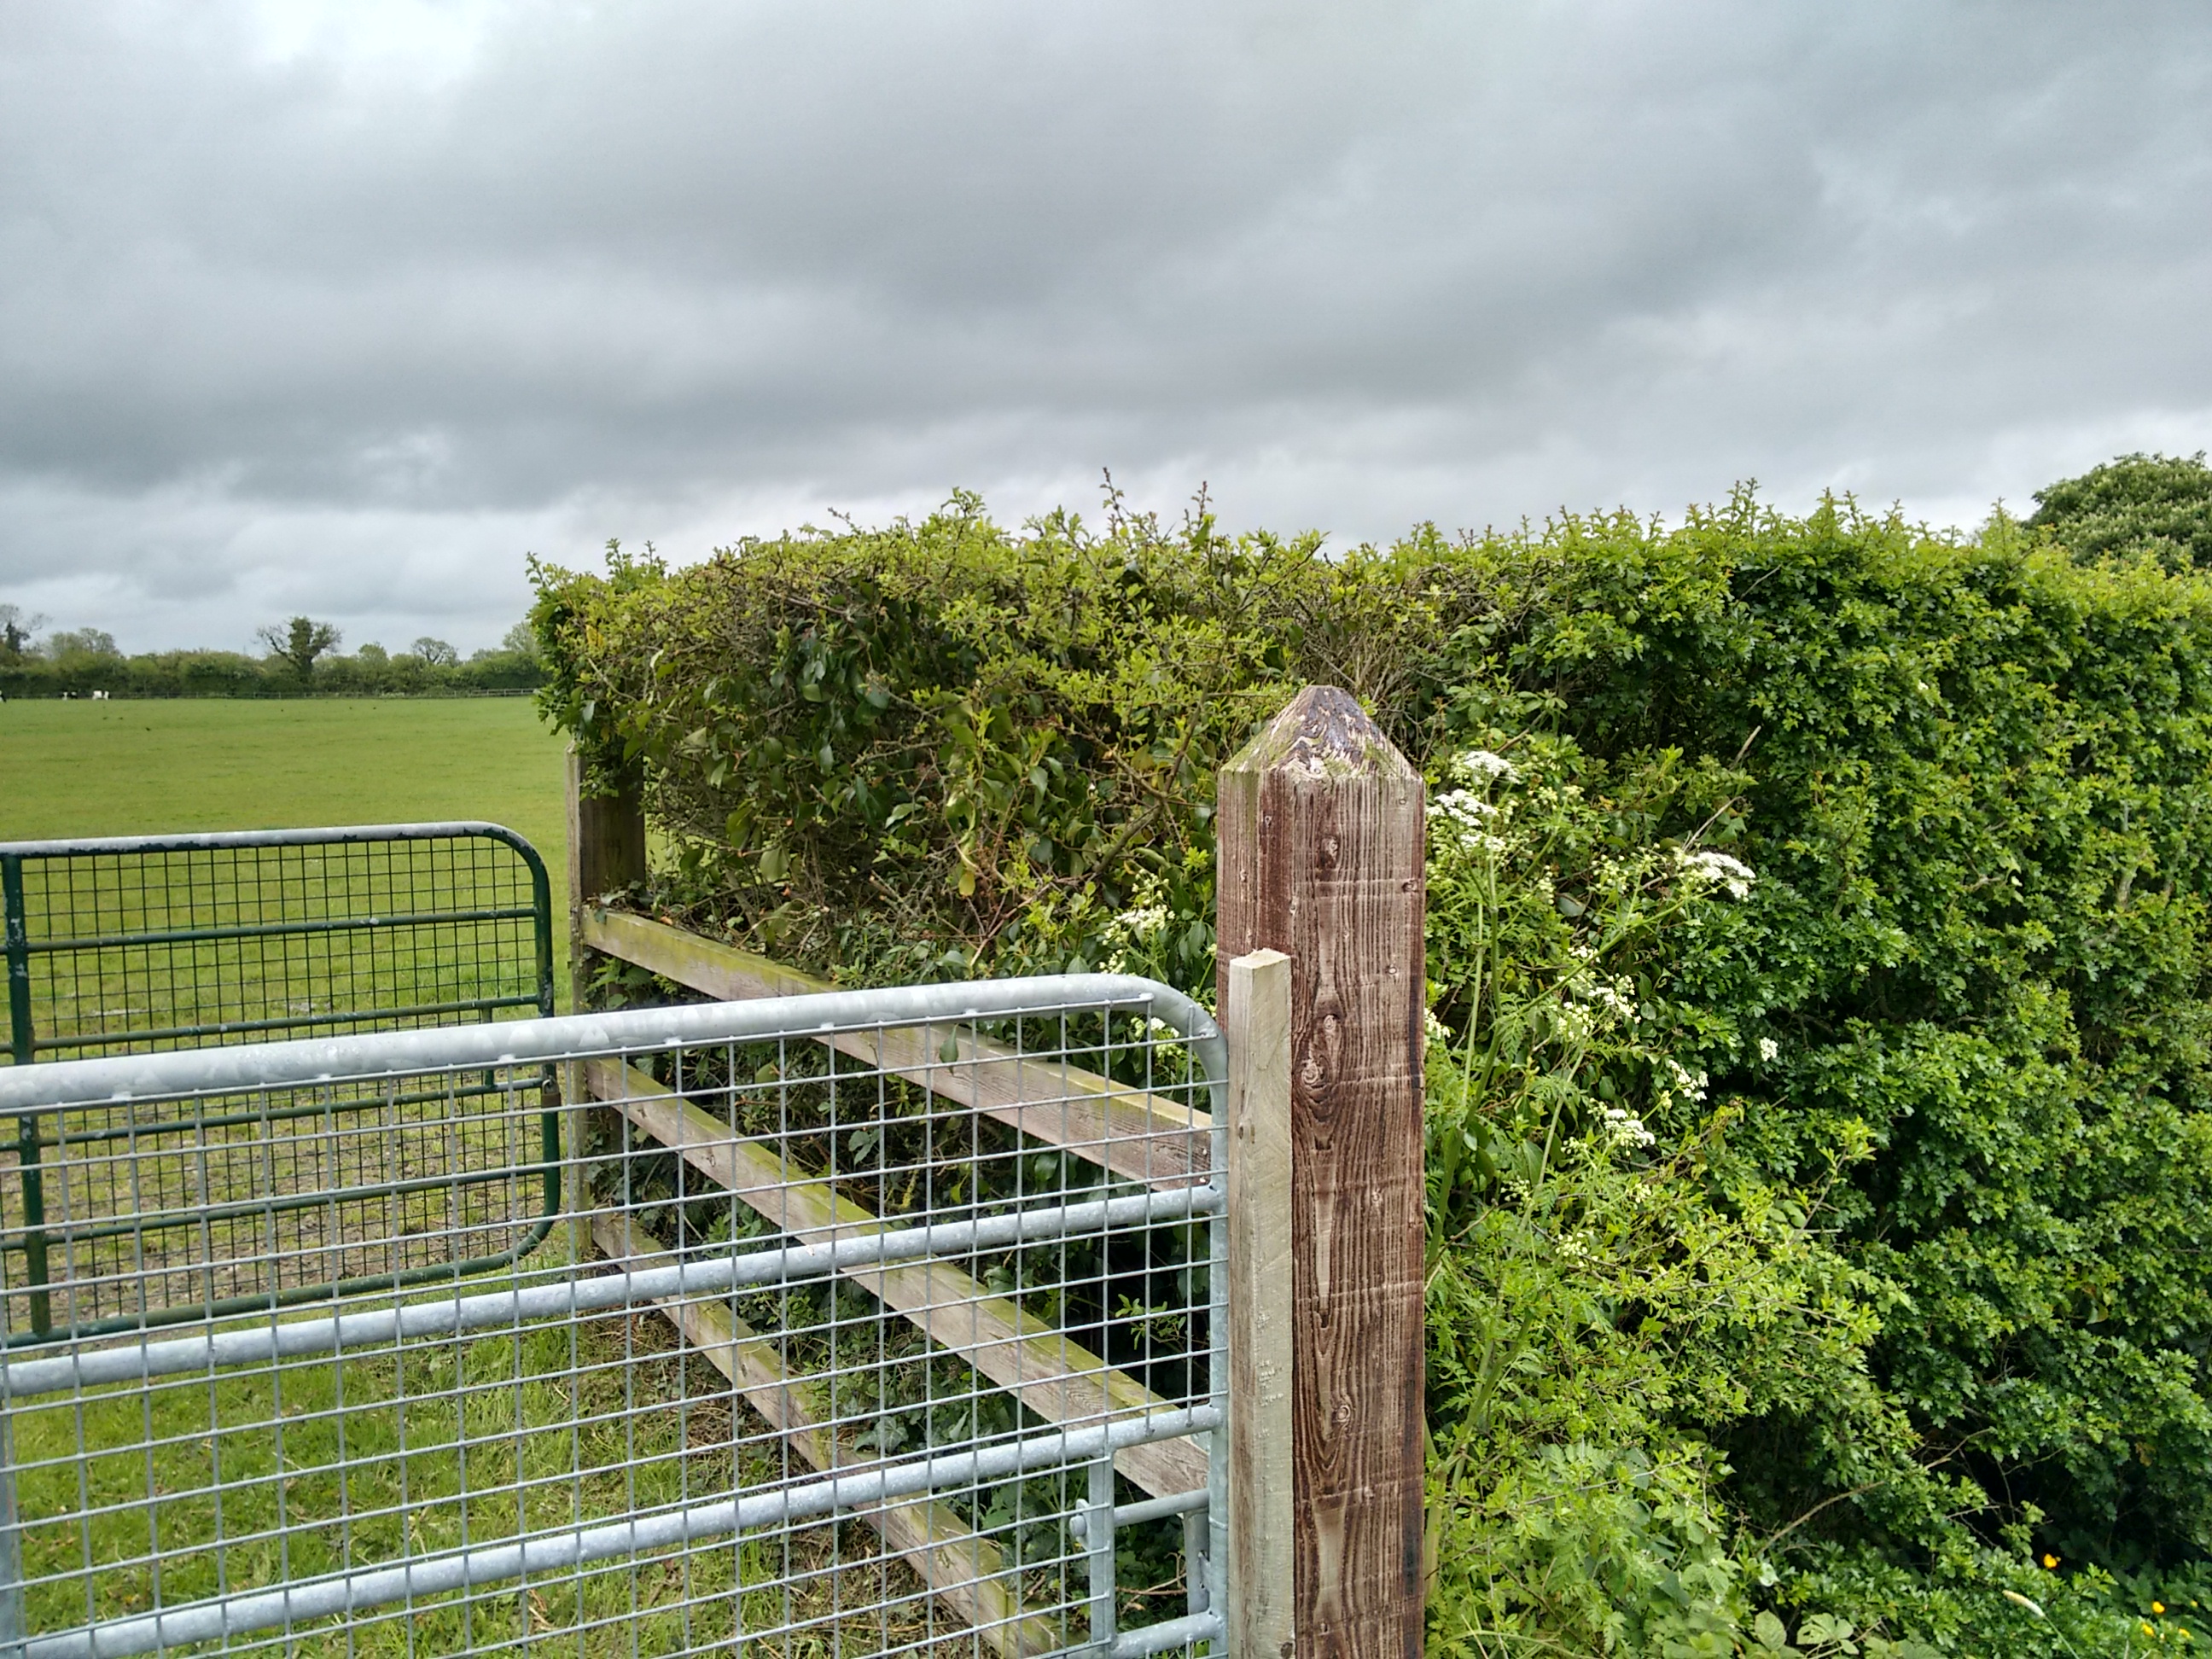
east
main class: Grassland
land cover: Grassland without tree/shrub cover
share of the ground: > 75 %
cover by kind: herbaceous plants 95 %, consolidated bare surface 5 %
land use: Agriculture (excluding fallow land and kitchen gardens)
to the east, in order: Grassland without tree/shrub cover; Managed hedges; Grassland without tree/shrub cover; Managed hedges; Grassland without tree/shrub cover
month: May
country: IE
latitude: 53.4281
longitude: -6.5477
